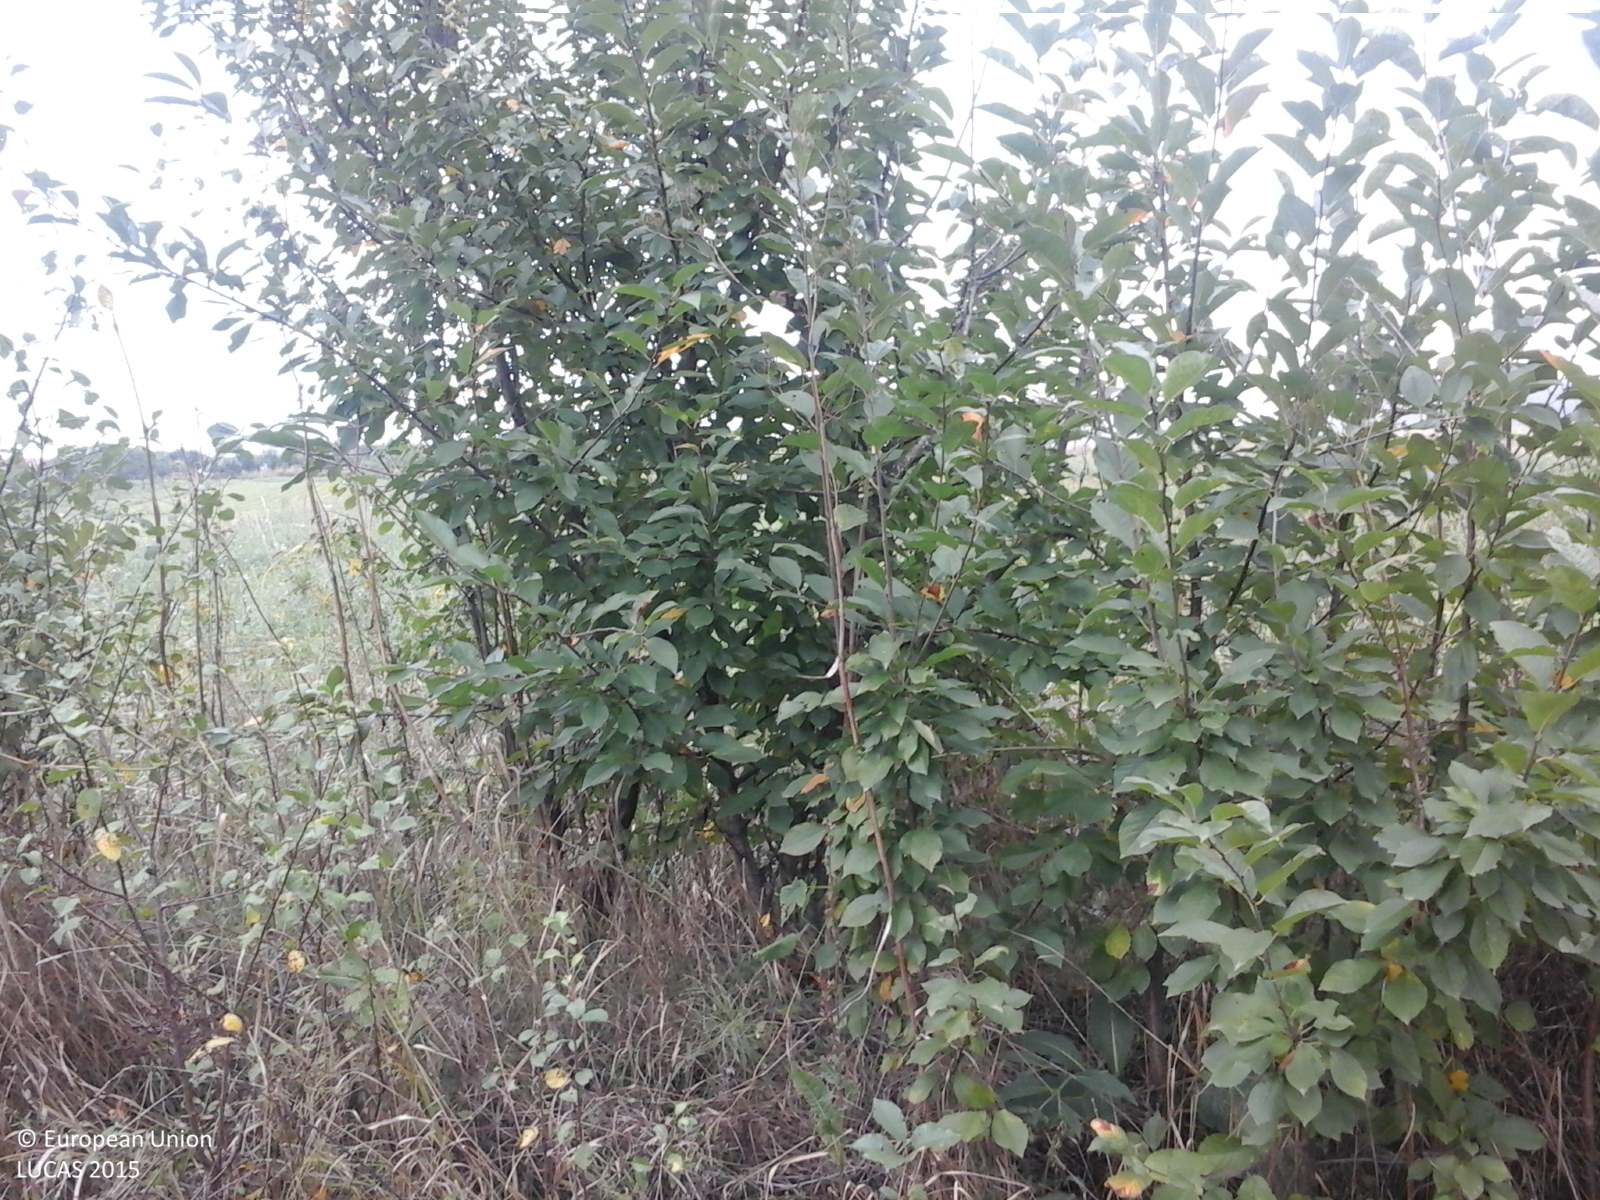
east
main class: Cropland
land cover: Other fruit trees and berries
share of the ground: 50 - 75 %
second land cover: Spontaneously vegetated surfaces
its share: > 75 %
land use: Agriculture (excluding fallow land and kitchen gardens)
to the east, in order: Other fruit trees and berries; Spontaneously vegetated surfaces; Ditches and canals; Grass margins; Tracks; Grass margins; Lucerne; Maize; Other bare soil; Vineyards; Grassland without tree/shrub cover; Other fruit trees and berries
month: September
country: RO
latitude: 47.0220
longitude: 22.3002
